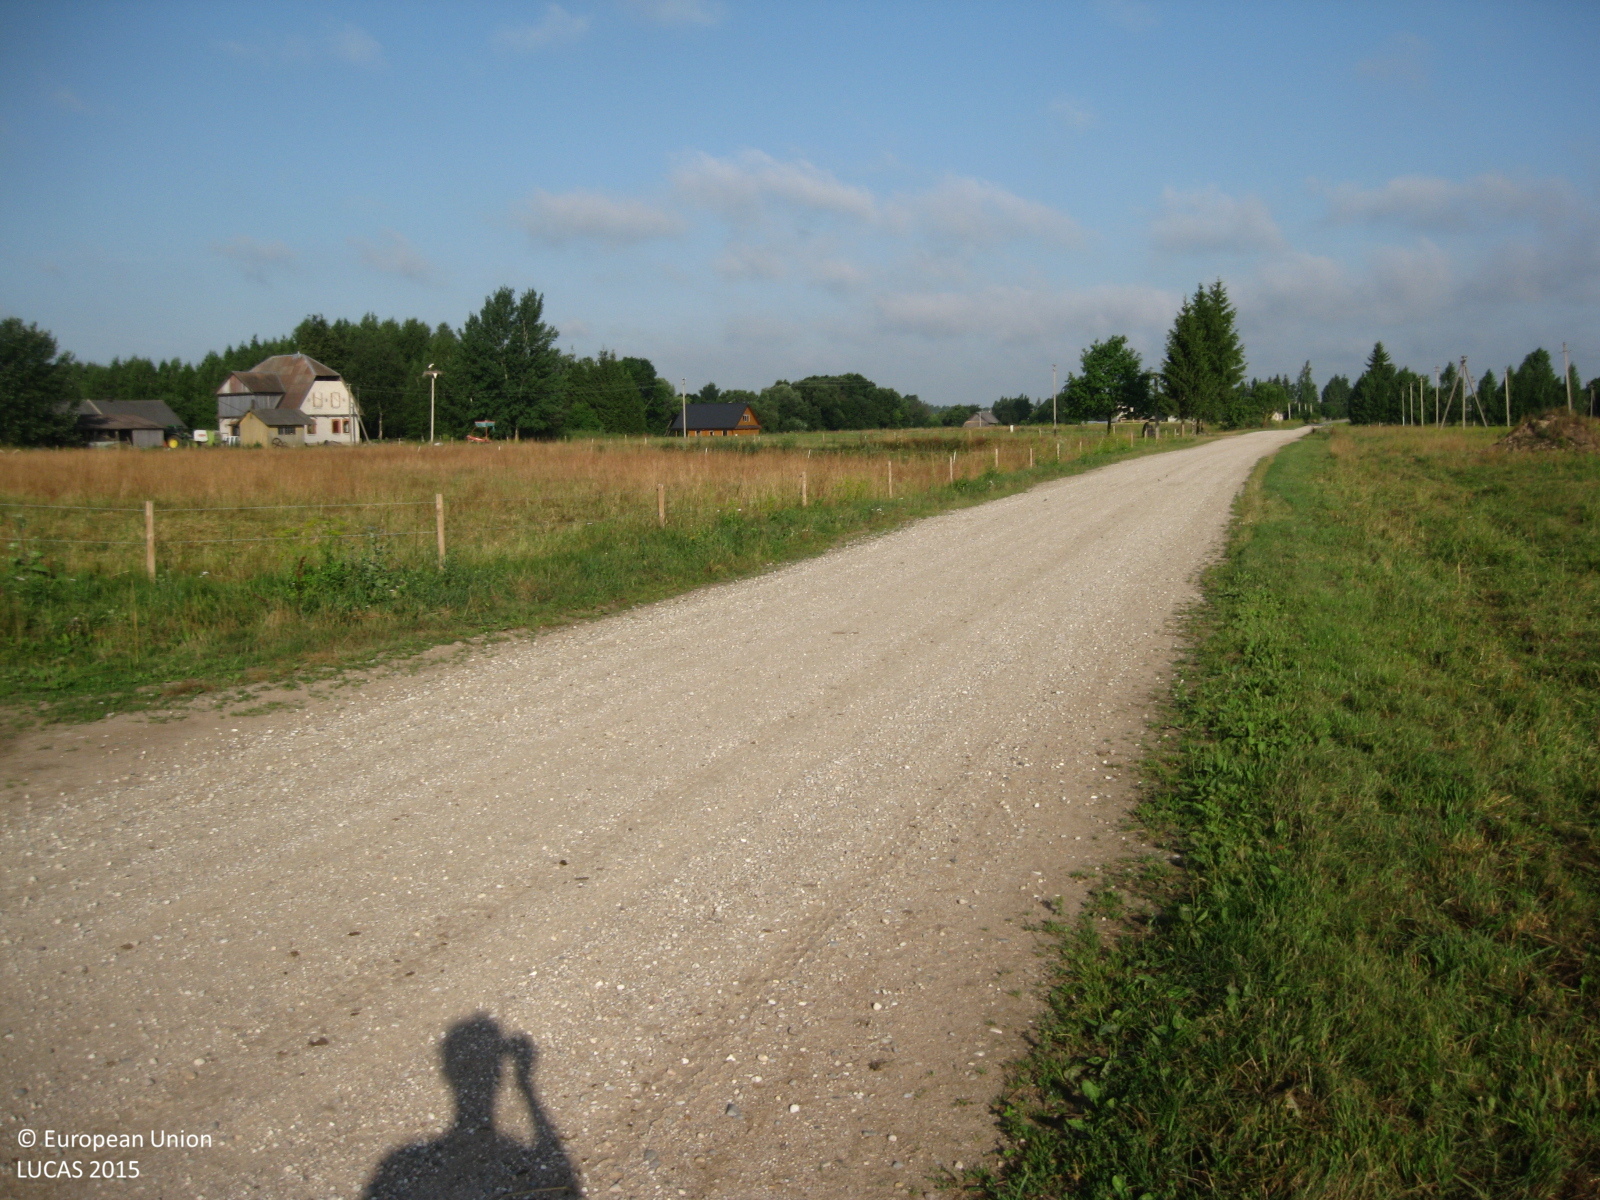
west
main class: Grassland
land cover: Grassland without tree/shrub cover
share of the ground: > 75 %
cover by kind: herbaceous plants 100 %
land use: Agriculture (excluding fallow land and kitchen gardens)
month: July
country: LT
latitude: 55.3118
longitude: 24.5819
